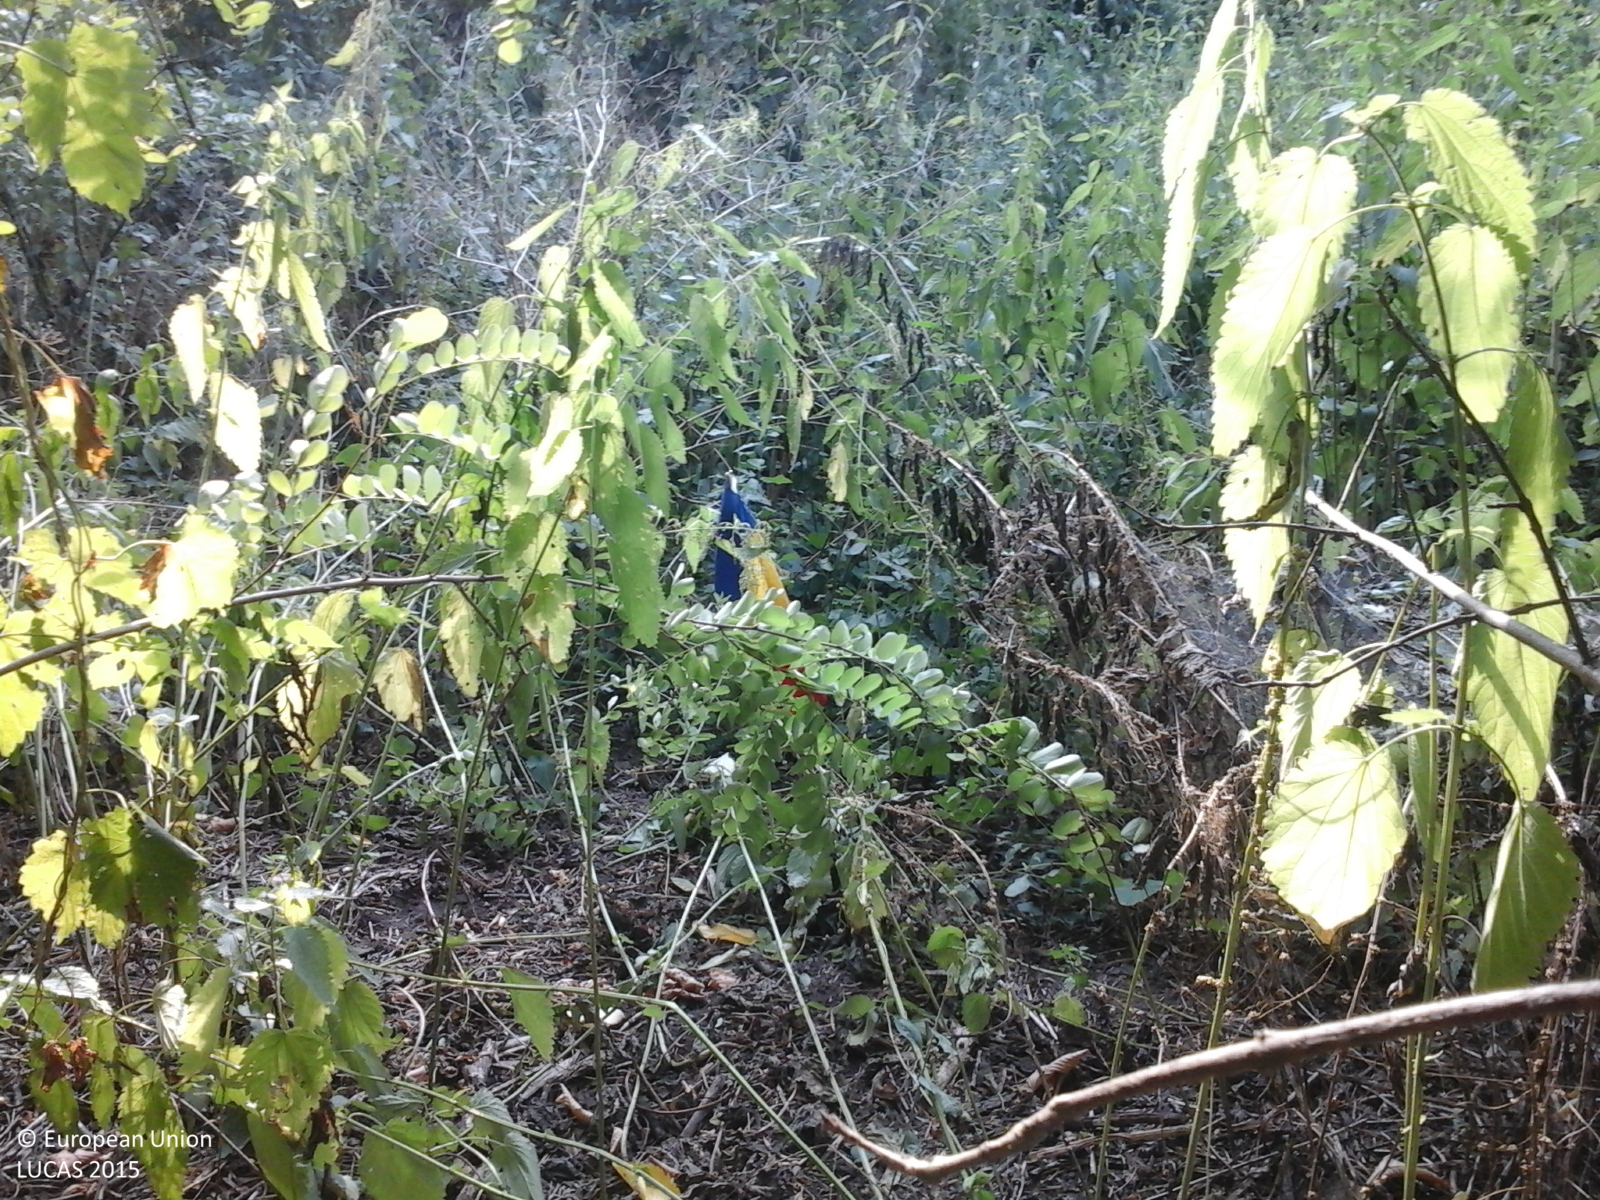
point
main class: Woodland
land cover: Broadleaved woodland
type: exotic forest
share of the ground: > 75 %
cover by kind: broadleaved forest trees 100 %
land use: Forestry
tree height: > 5 m
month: August
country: RO
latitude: 44.0012
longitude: 27.9723
